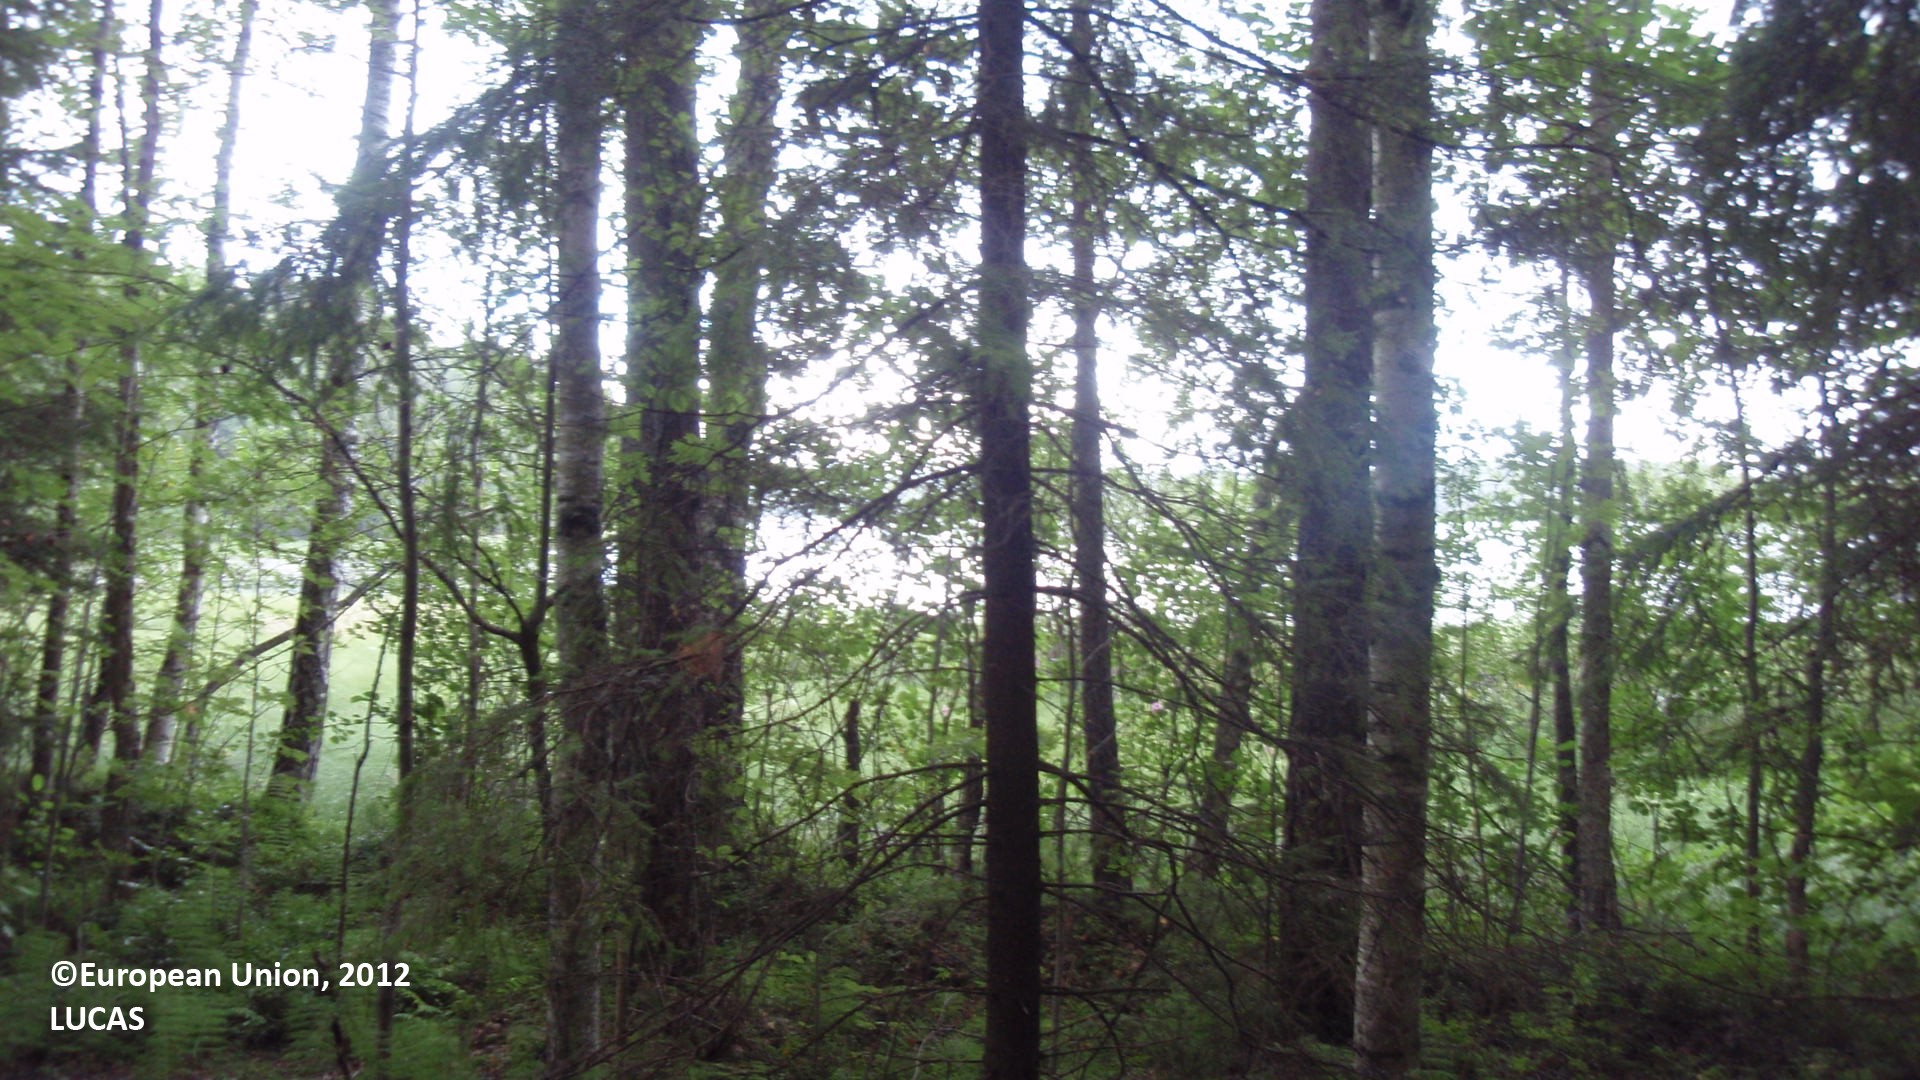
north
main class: Woodland
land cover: Other coniferous woodland
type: boreal forest
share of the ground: 50 - 75 %
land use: Forestry
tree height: > 5 m
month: August
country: FI
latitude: 60.9591
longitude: 26.9140
